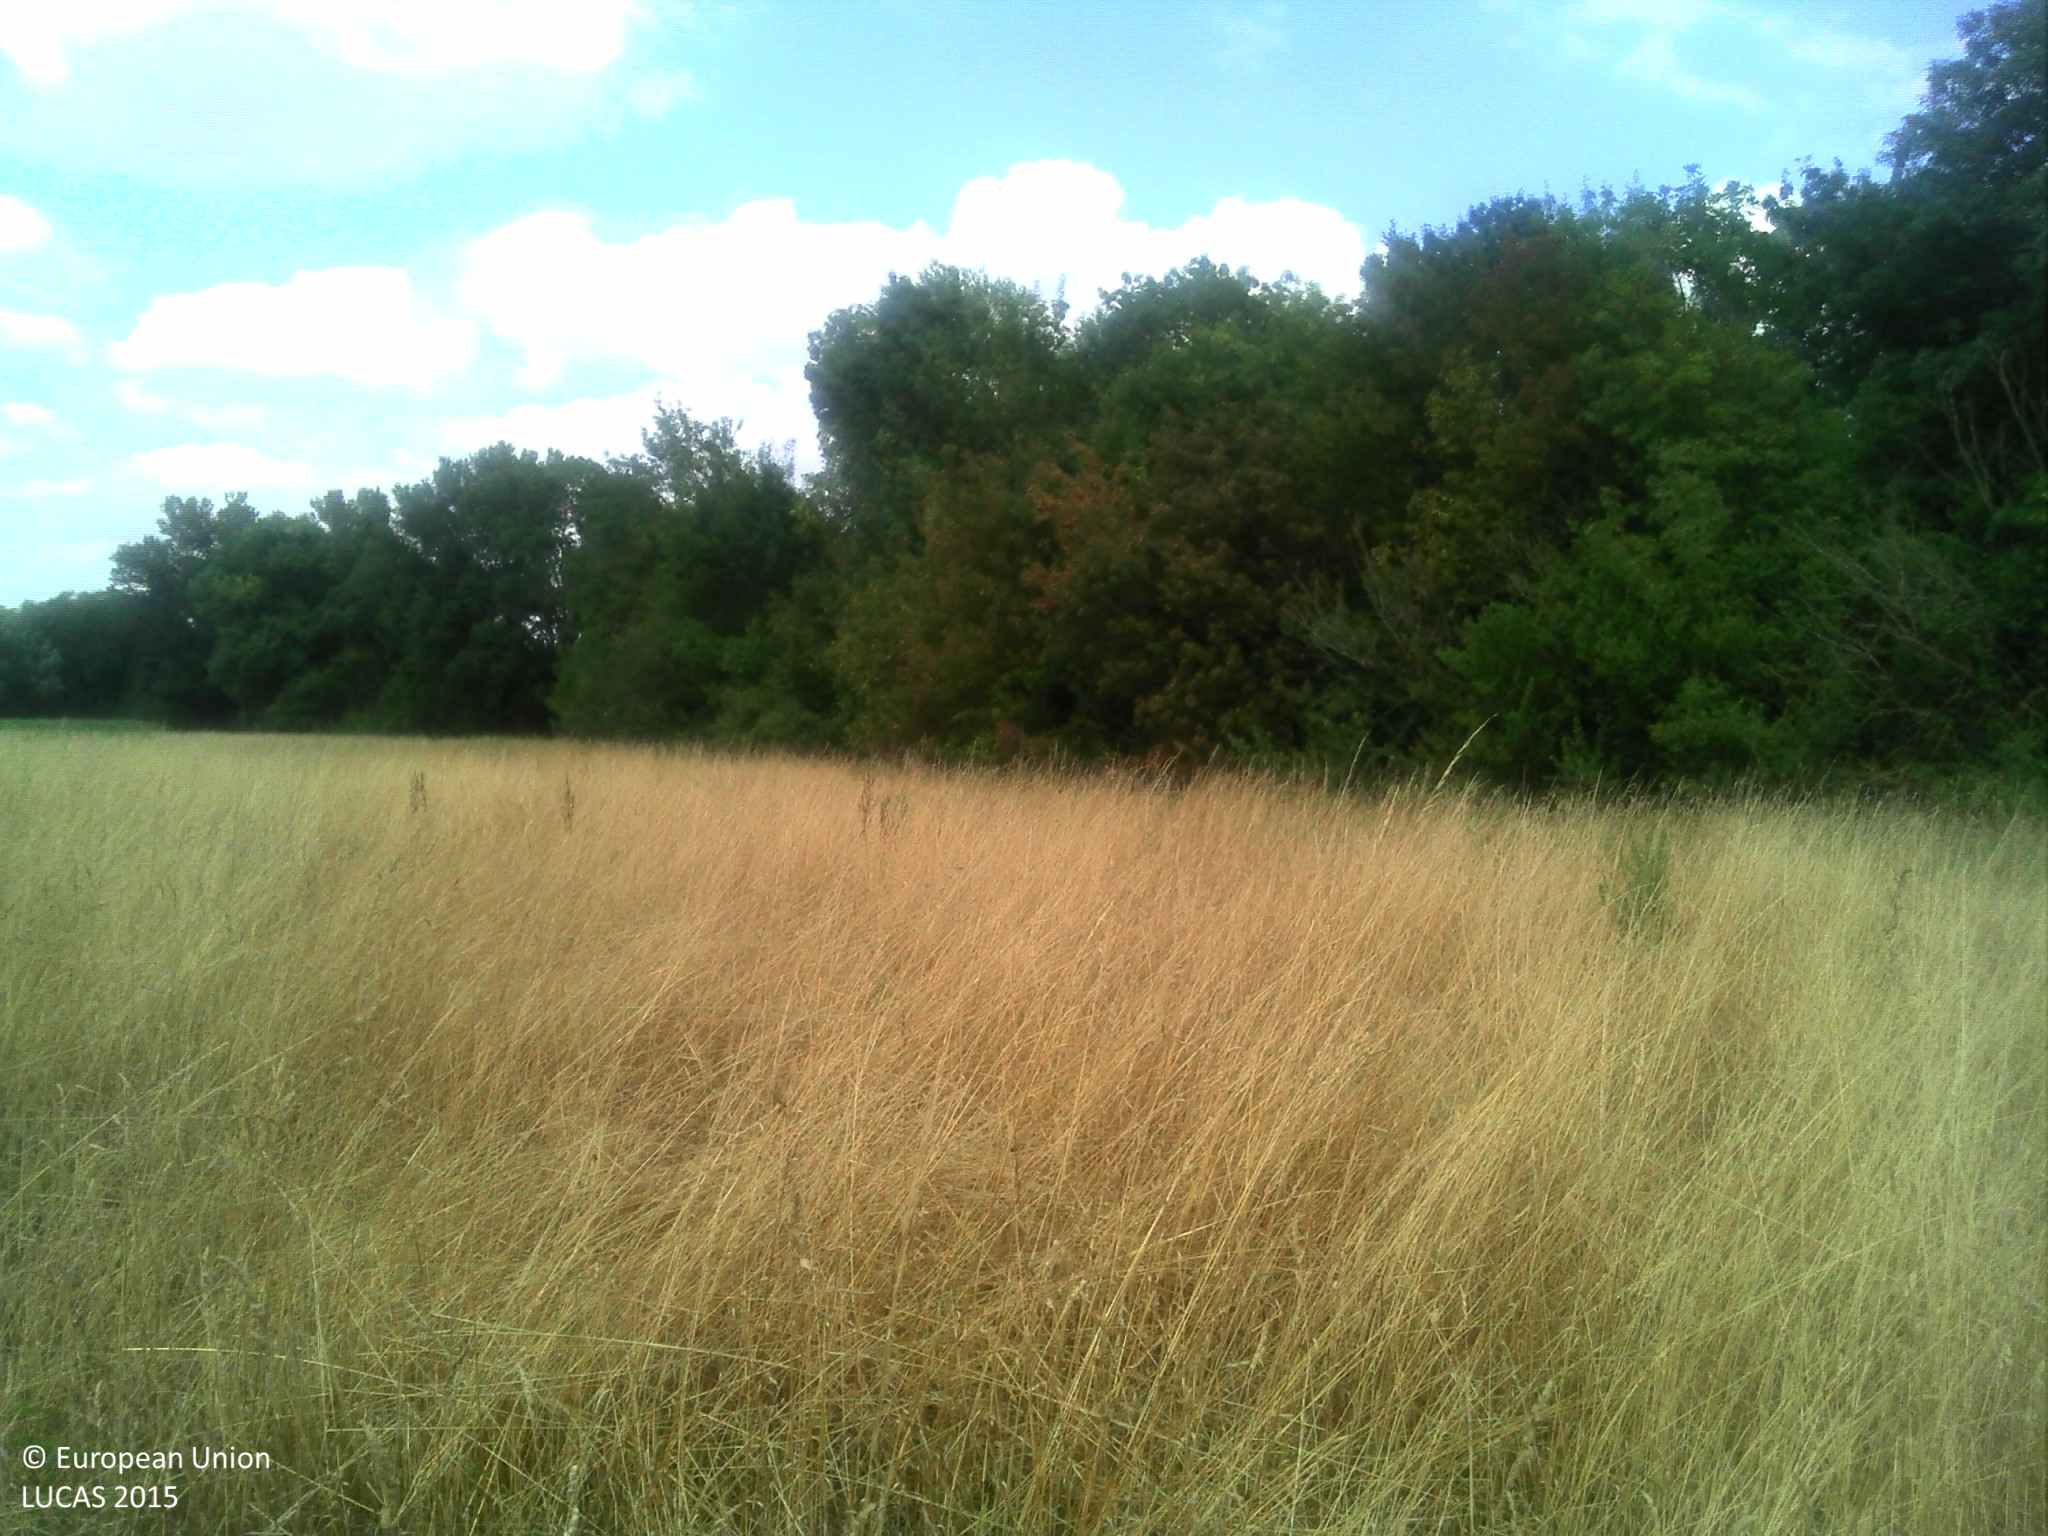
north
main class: Grassland
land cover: Grassland without tree/shrub cover
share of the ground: > 75 %
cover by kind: herbaceous plants 95 %, shrubs 5 %
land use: Agriculture (excluding fallow land and kitchen gardens)
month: July
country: FR
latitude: 43.8911
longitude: 0.6481
